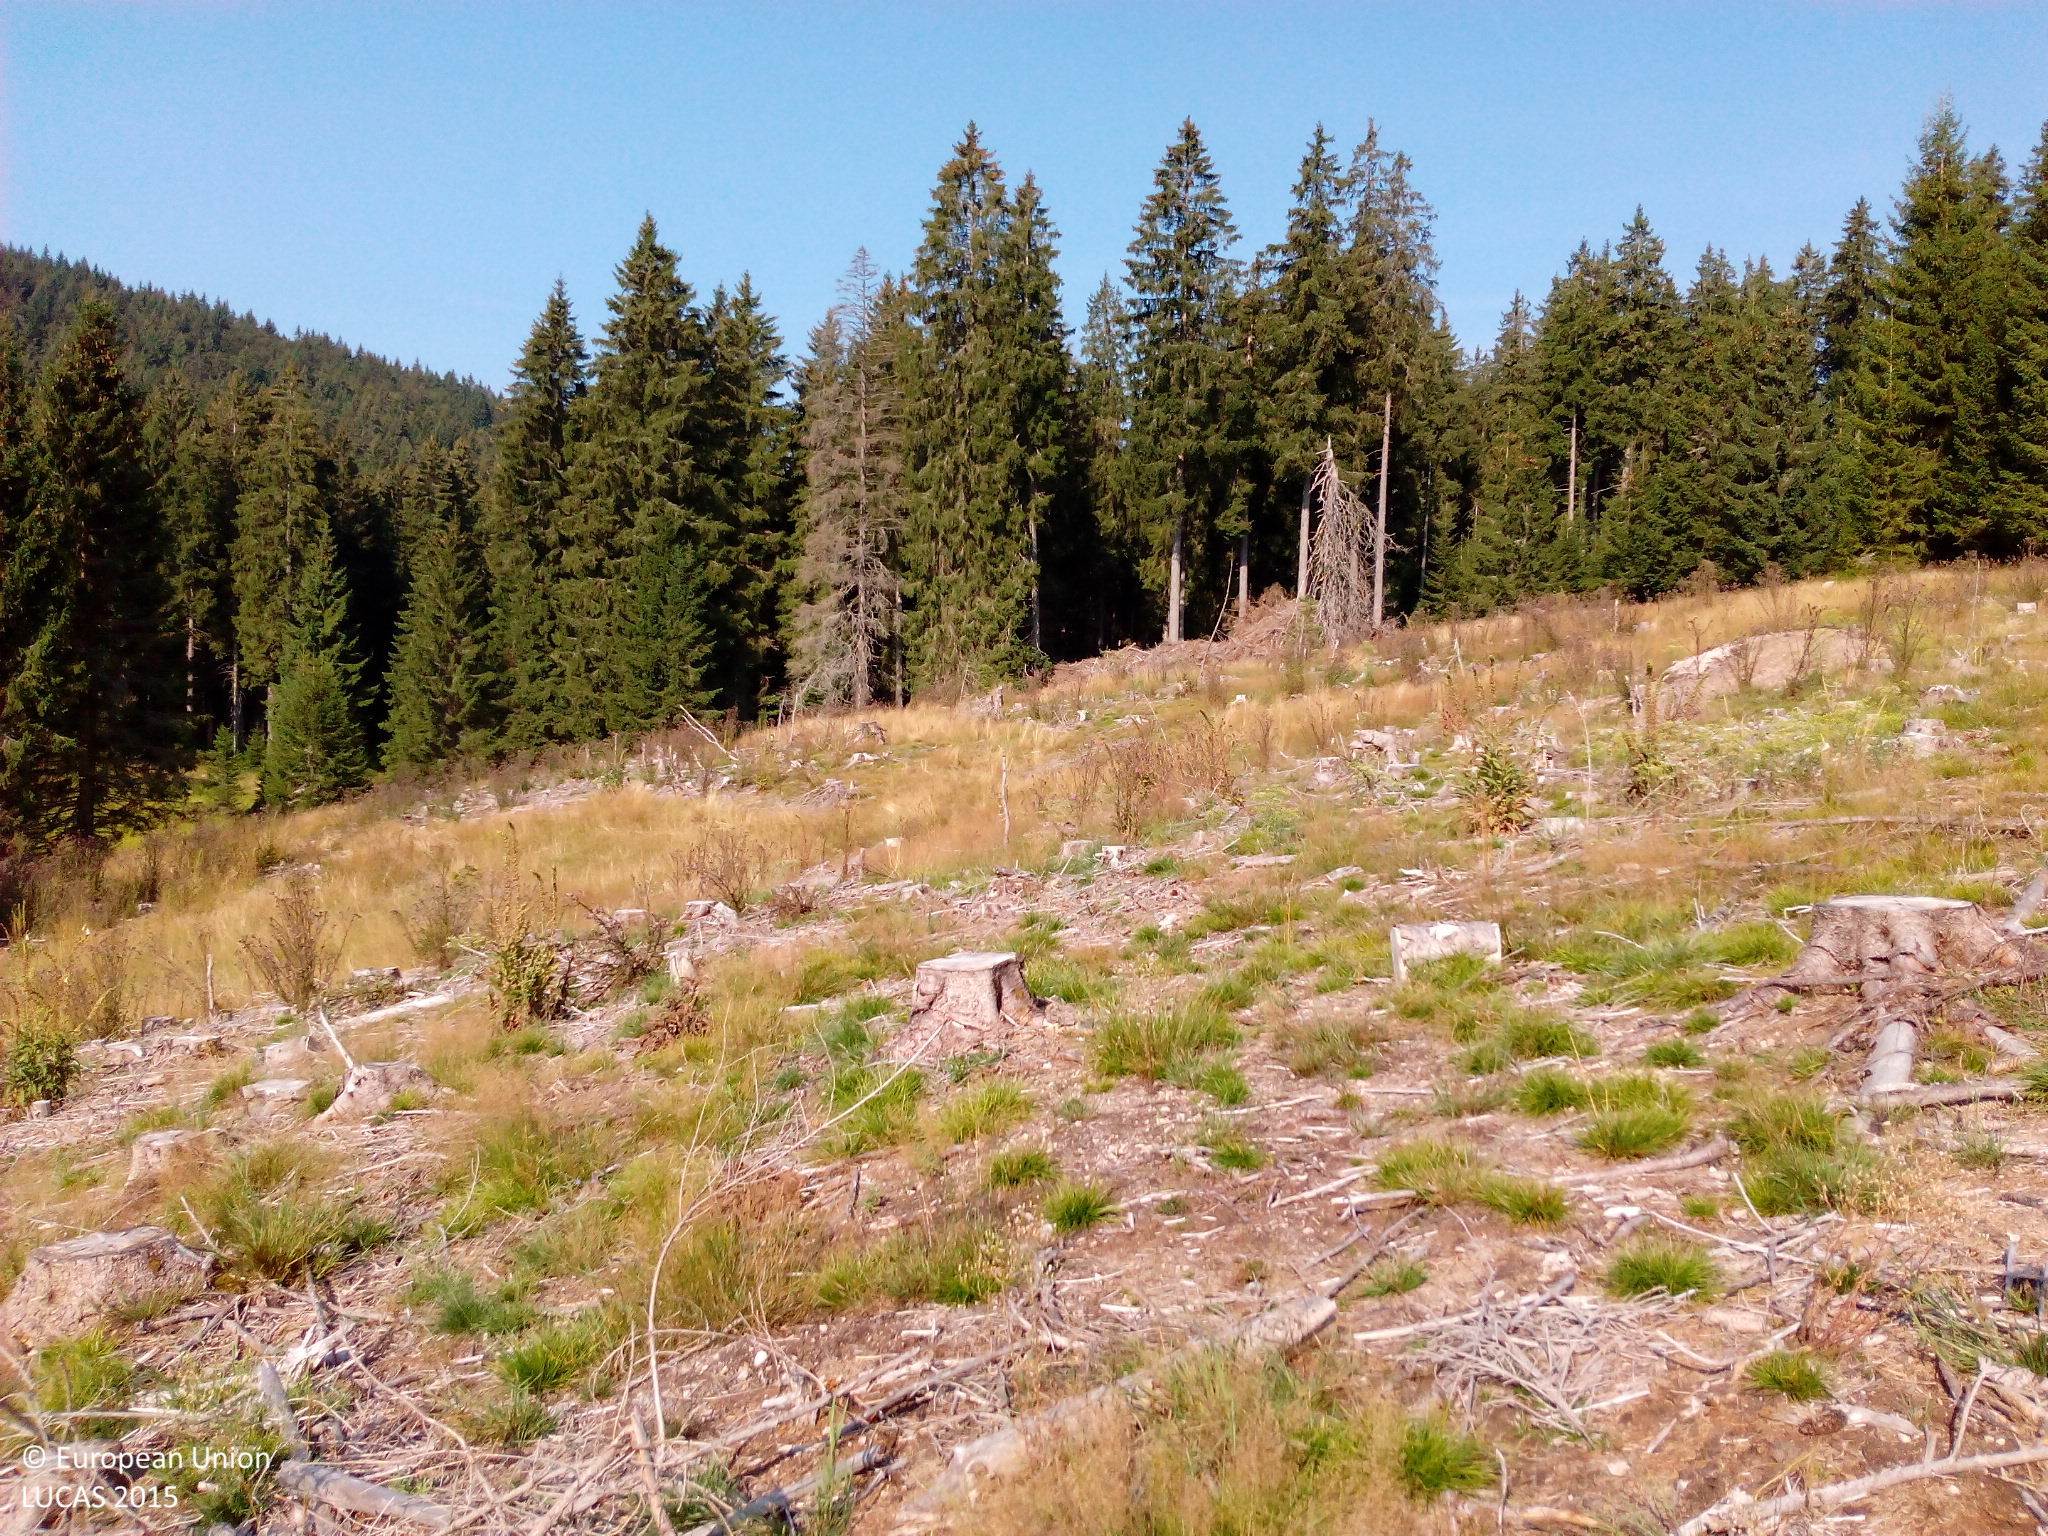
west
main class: Grassland
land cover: Spontaneously vegetated surfaces
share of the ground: 50 - 75 %
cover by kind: herbaceous plants 50 %, unconsolidated bare surface 50 %
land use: Forestry
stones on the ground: 10 - 25 %
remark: Clear cut
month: August
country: DE
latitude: 47.8115
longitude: 8.1183
